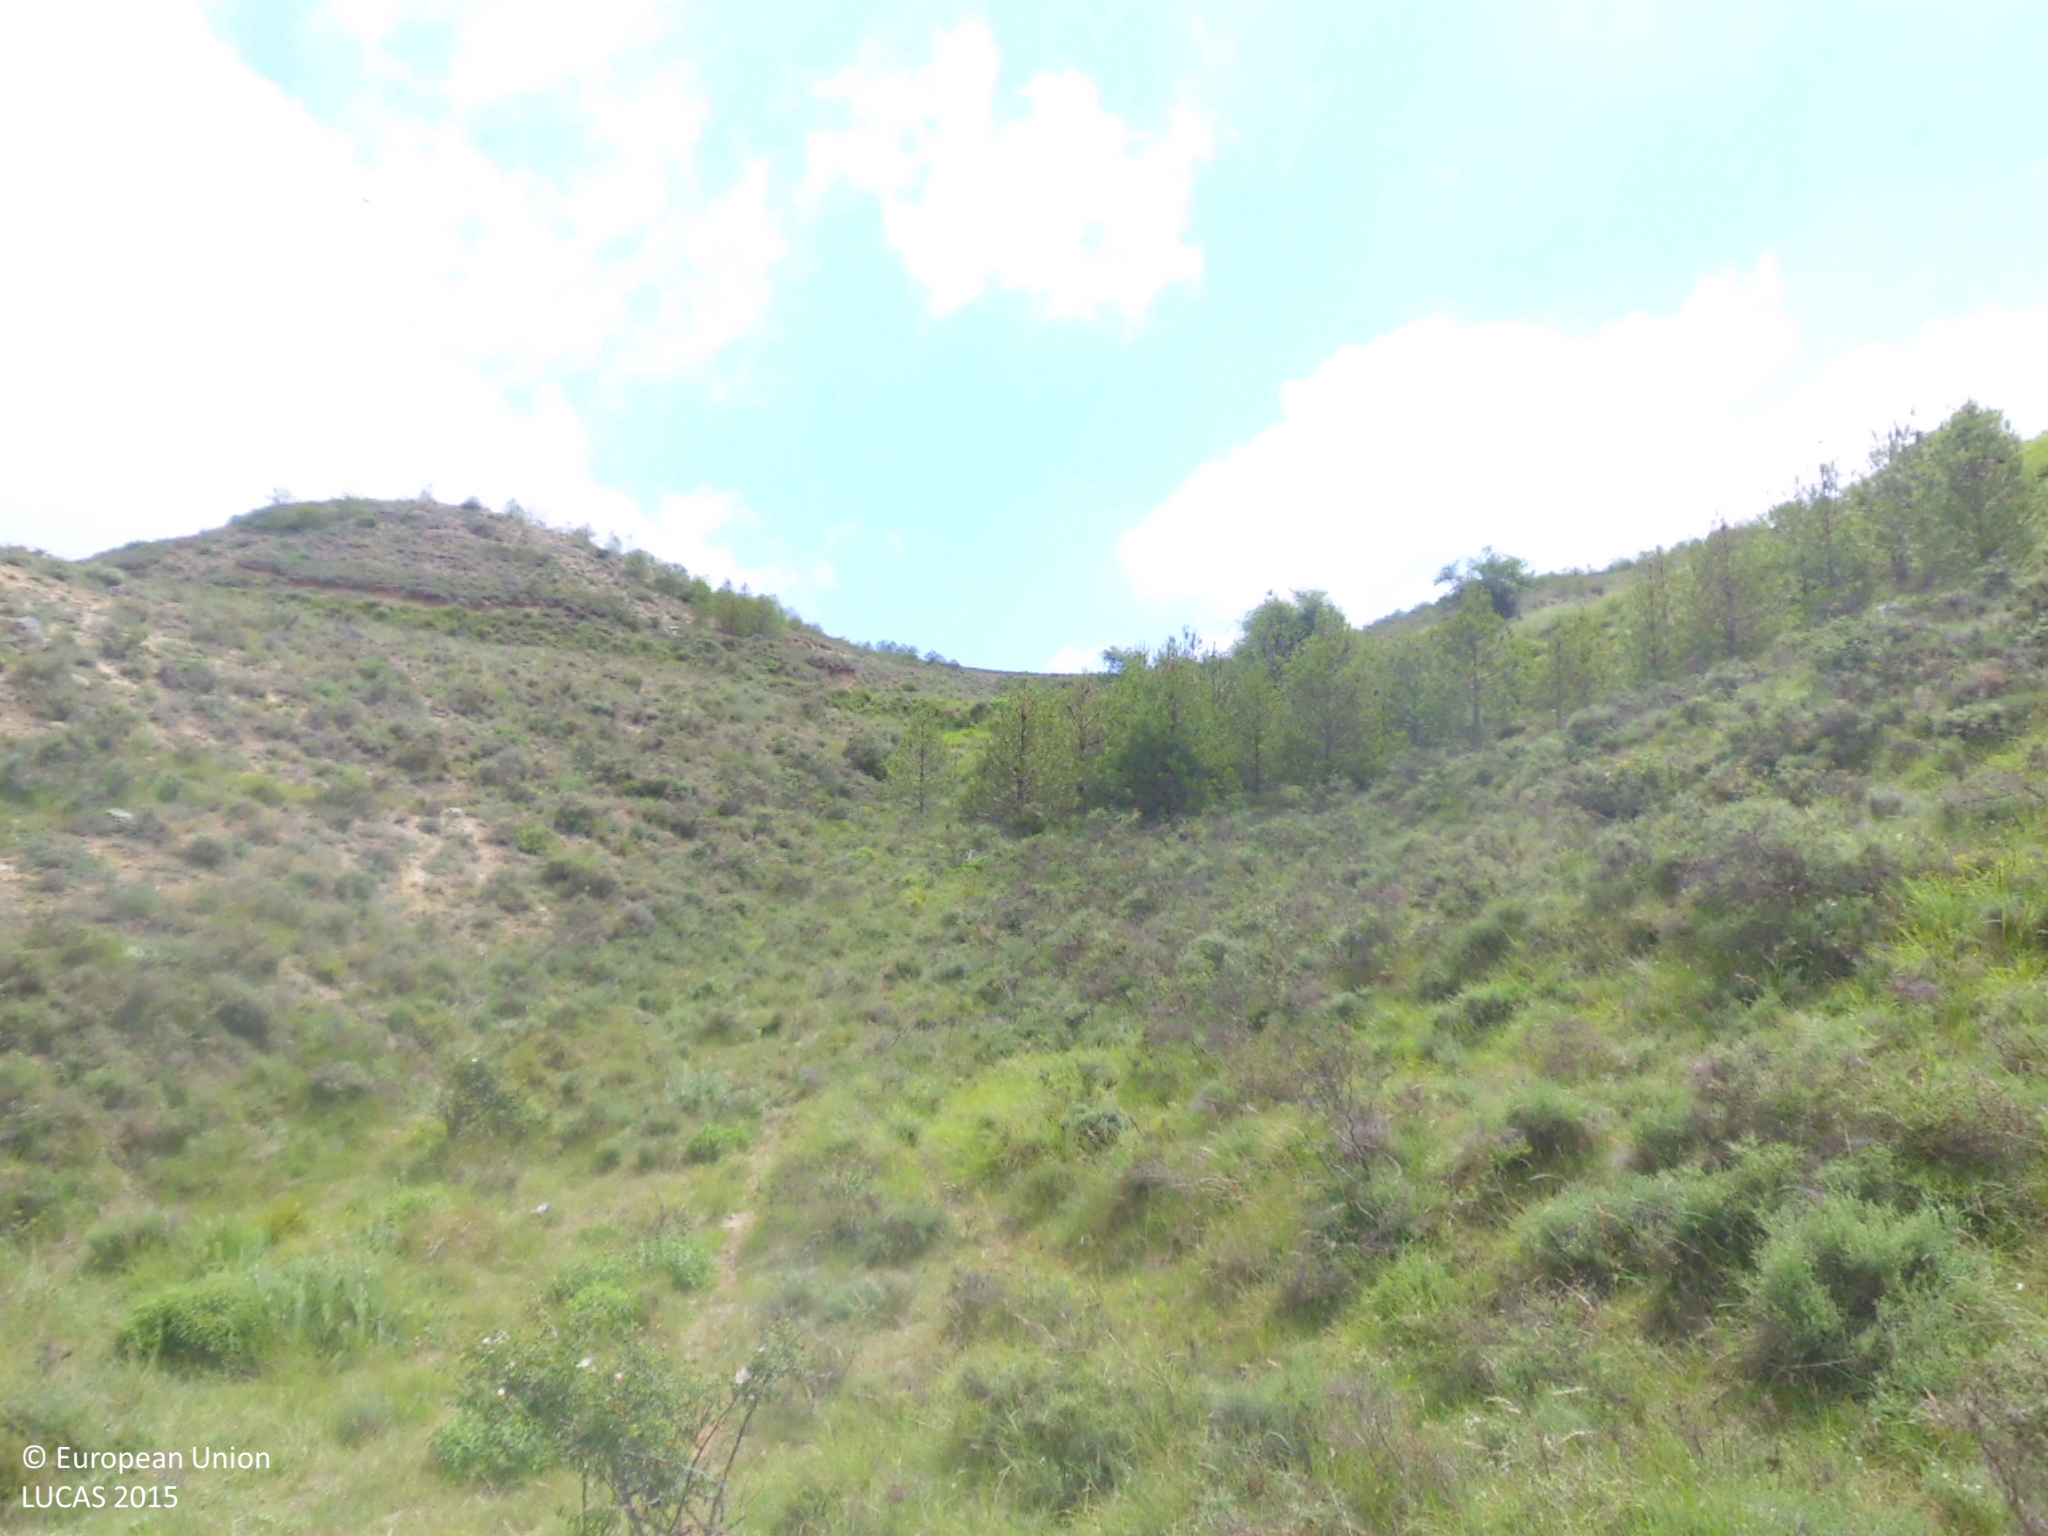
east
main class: Shrubland
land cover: Shrubland without tree cover
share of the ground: 50 - 75 %
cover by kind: shrubs 55 %, herbaceous plants 30 %, consolidated bare surface 15 %
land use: Semi-natural and natural areas not in use
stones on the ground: < 10 %
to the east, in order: Shrubland without tree cover; Pine dominated coniferous woodland; Shrubland without tree cover; Common wheat
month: June
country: ES
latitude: 42.4752
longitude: -3.3764
